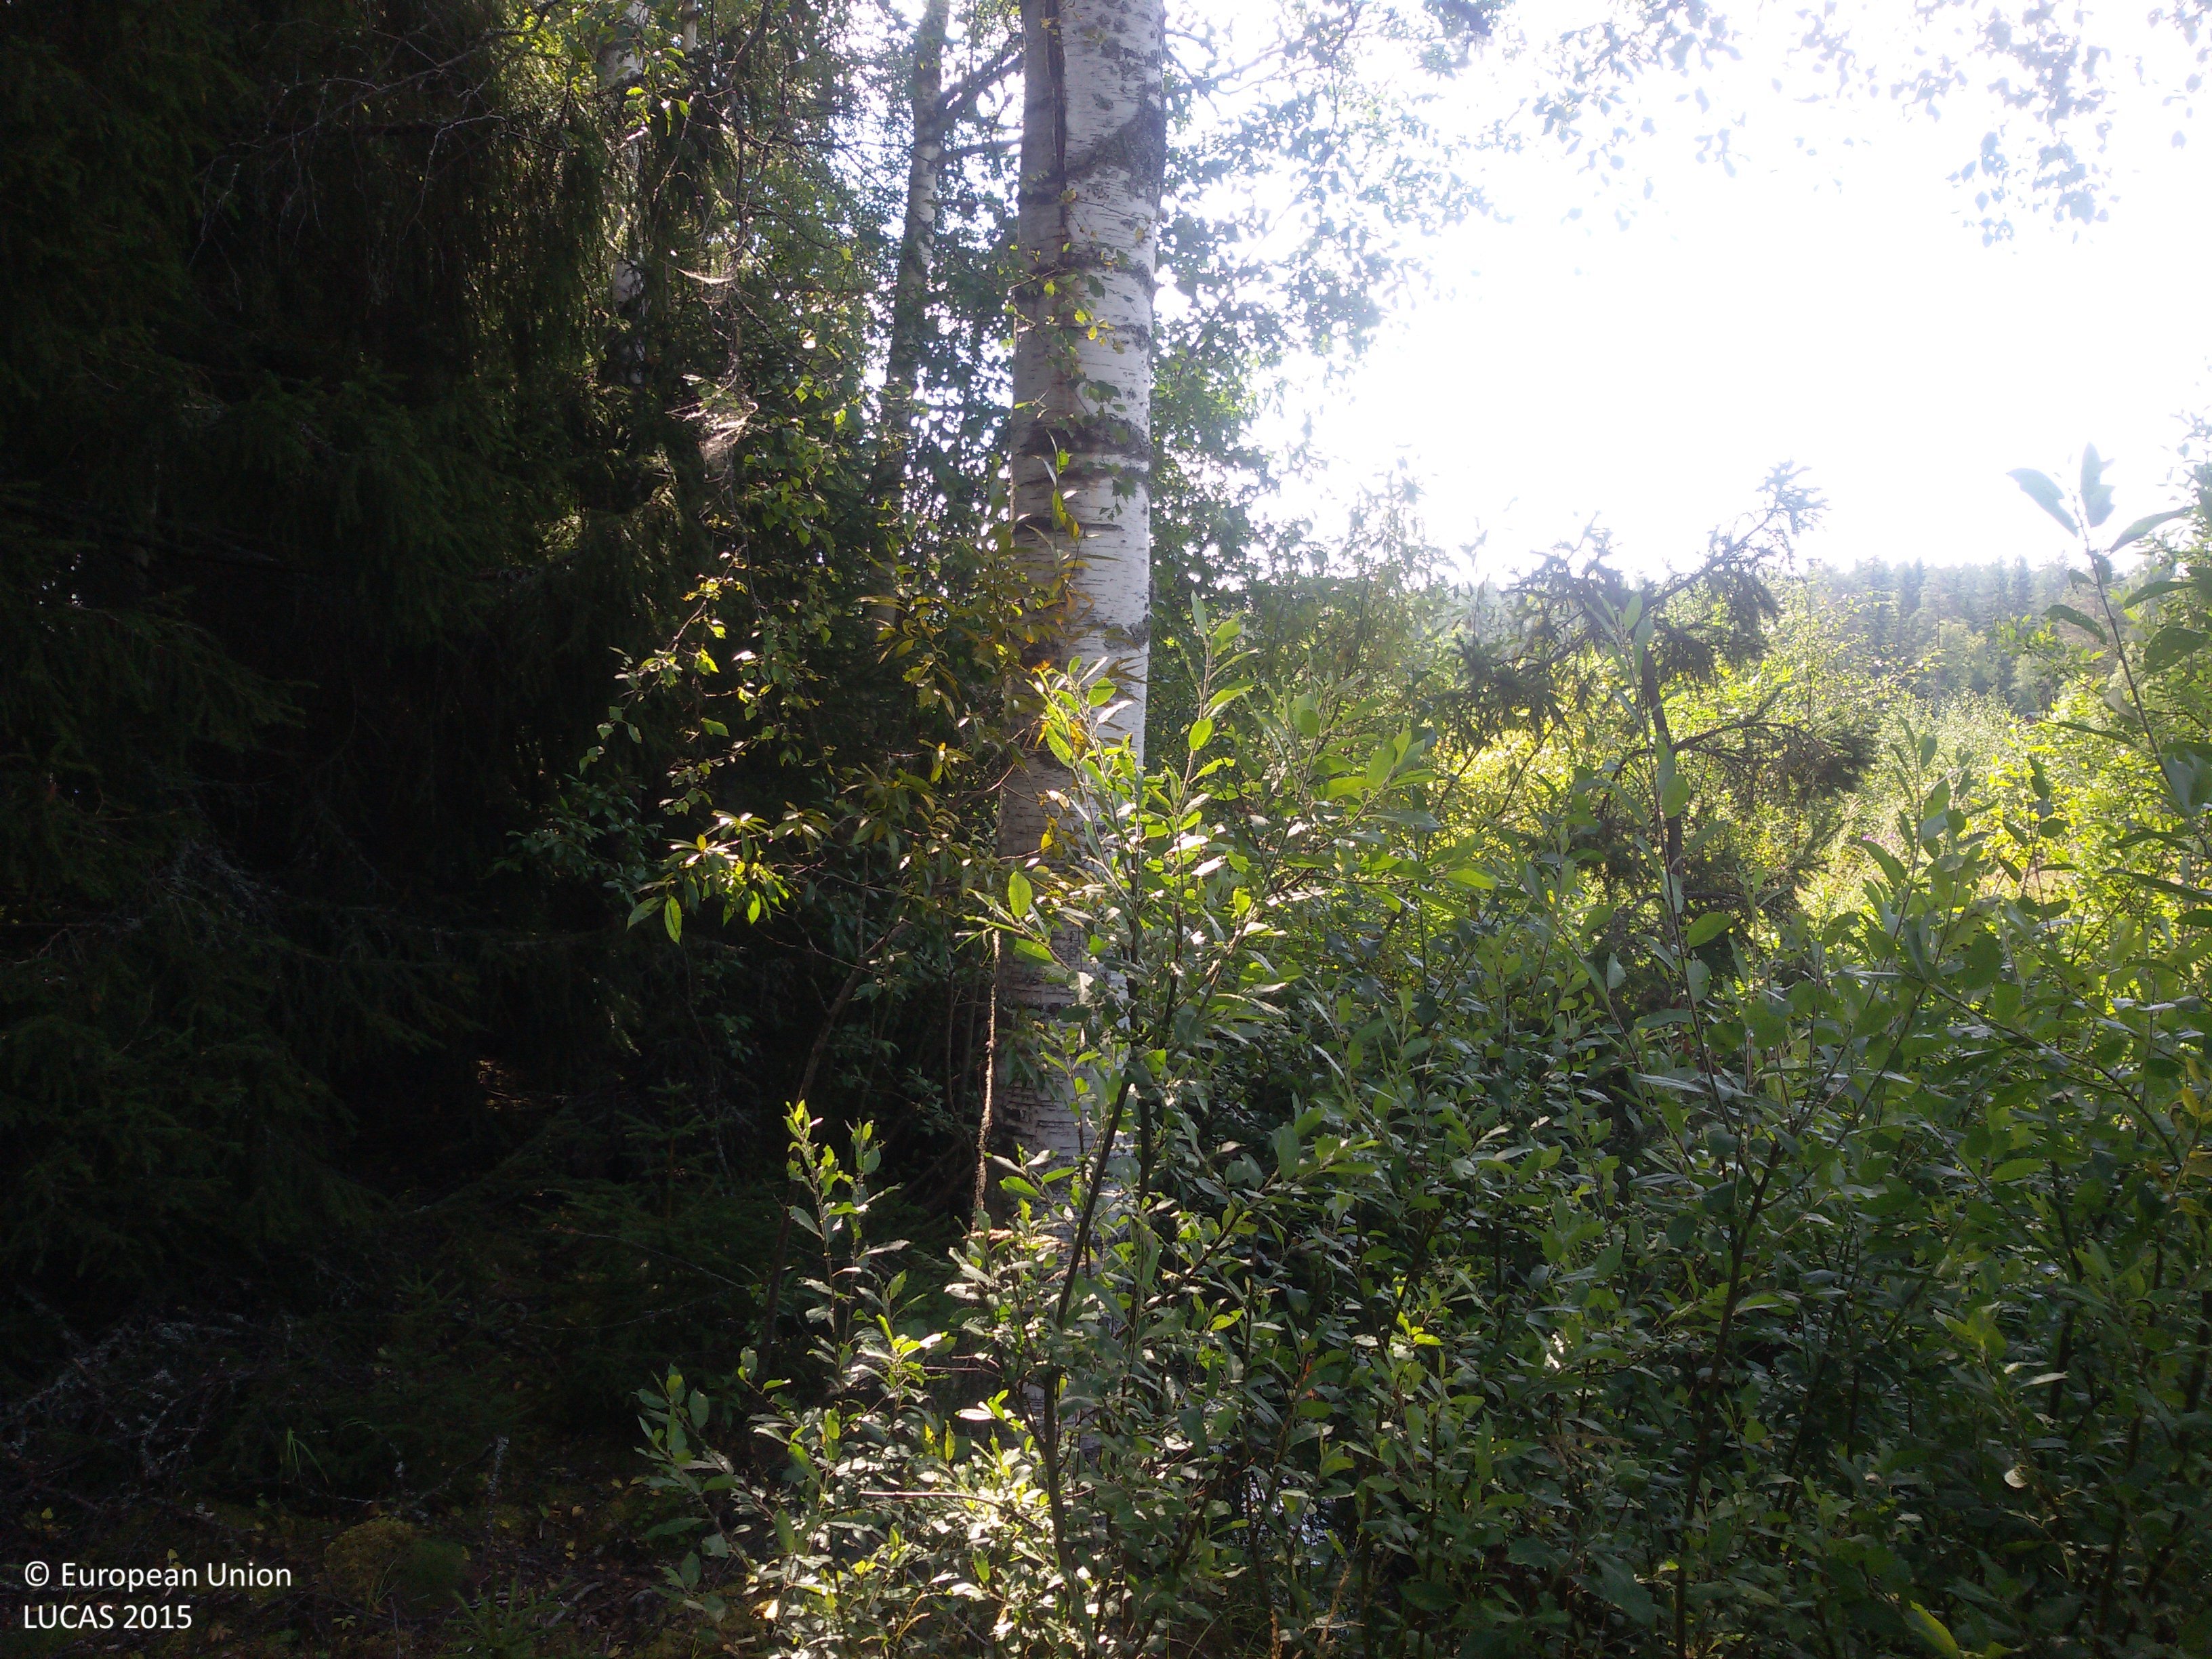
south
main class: Shrubland
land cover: Shrubland with sparse tree cover
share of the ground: > 75 %
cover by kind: shrubs 90 %, broadleaved forest trees 5 %, herbaceous plants 5 %
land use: Semi-natural and natural areas not in use
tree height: < 5 m
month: August
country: SE
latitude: 60.7355
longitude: 16.0938
